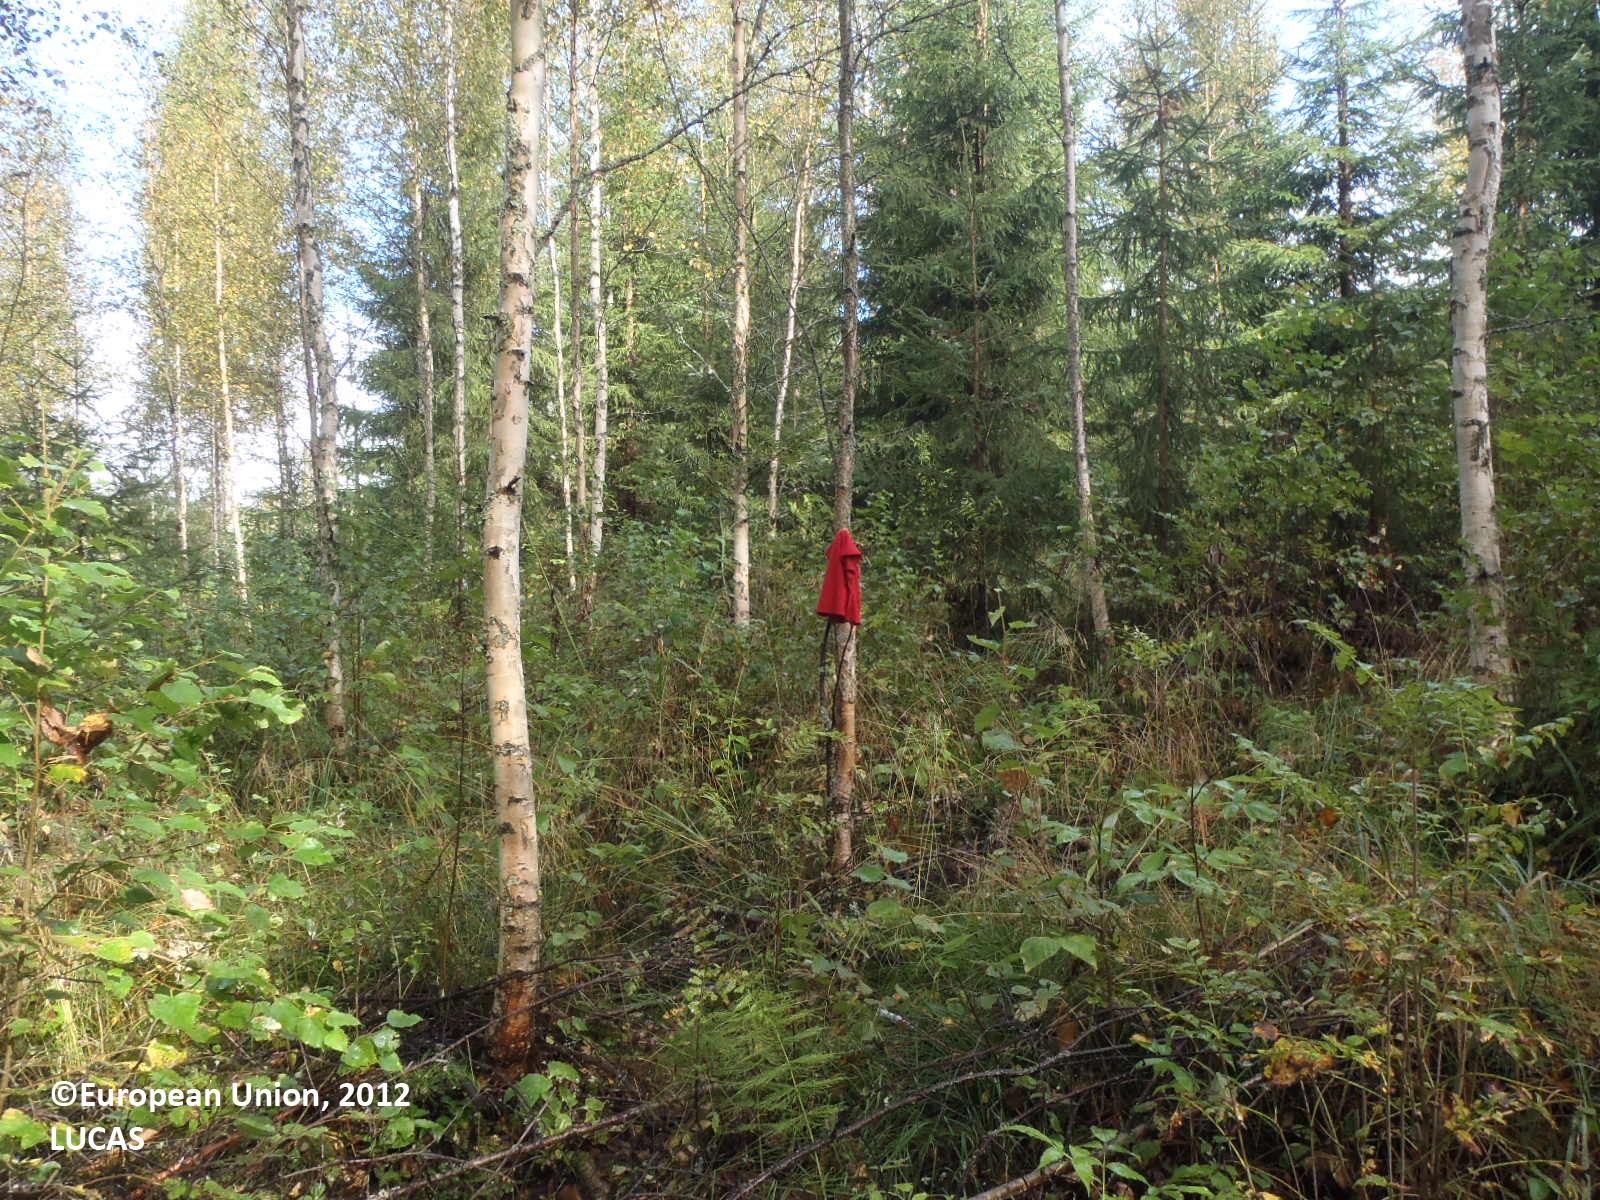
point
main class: Woodland
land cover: Spruce dominated mixed woodland
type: boreal forest
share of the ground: > 75 %
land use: Forestry
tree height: > 5 m
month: September
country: FI
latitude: 61.6097
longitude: 22.7545
